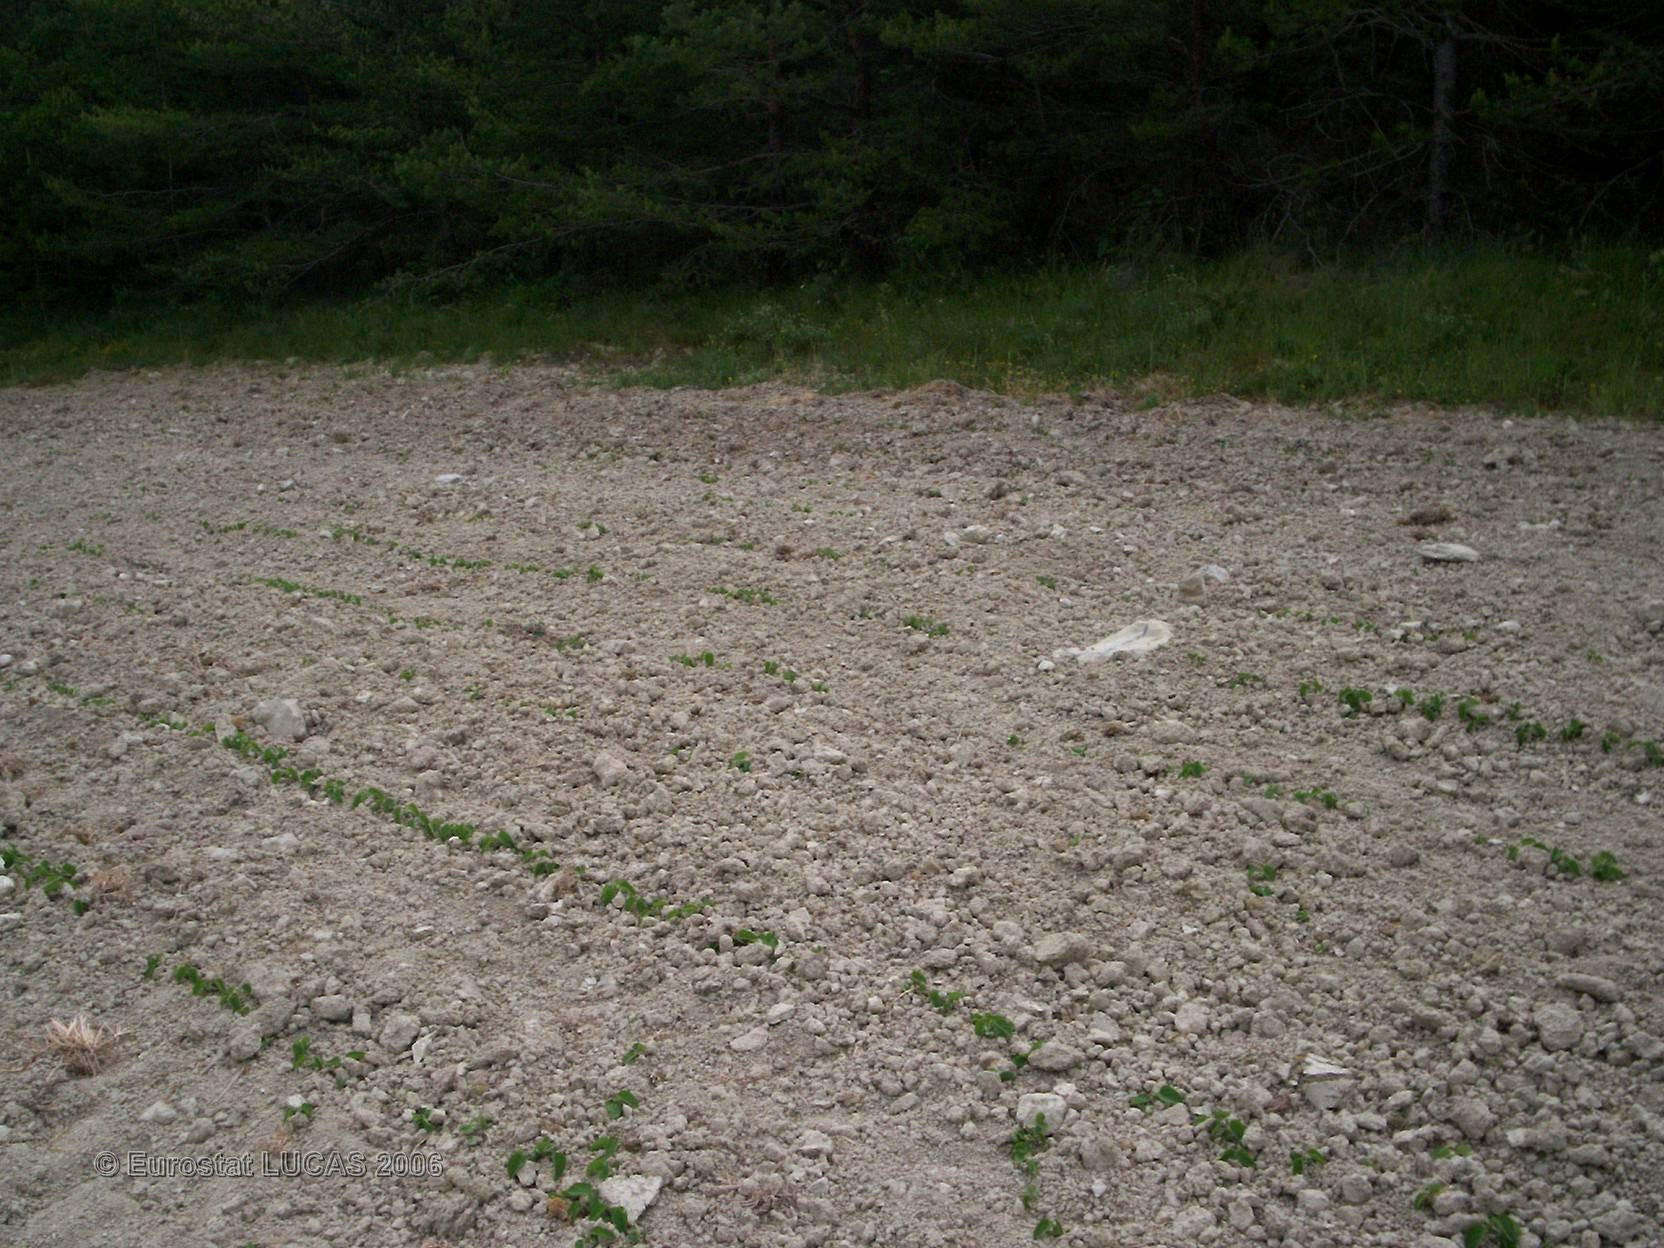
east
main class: Cropland
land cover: Soya
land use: Agriculture (excluding fallow land and kitchen gardens)
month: June
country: FR
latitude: 44.5341
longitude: 4.9354
